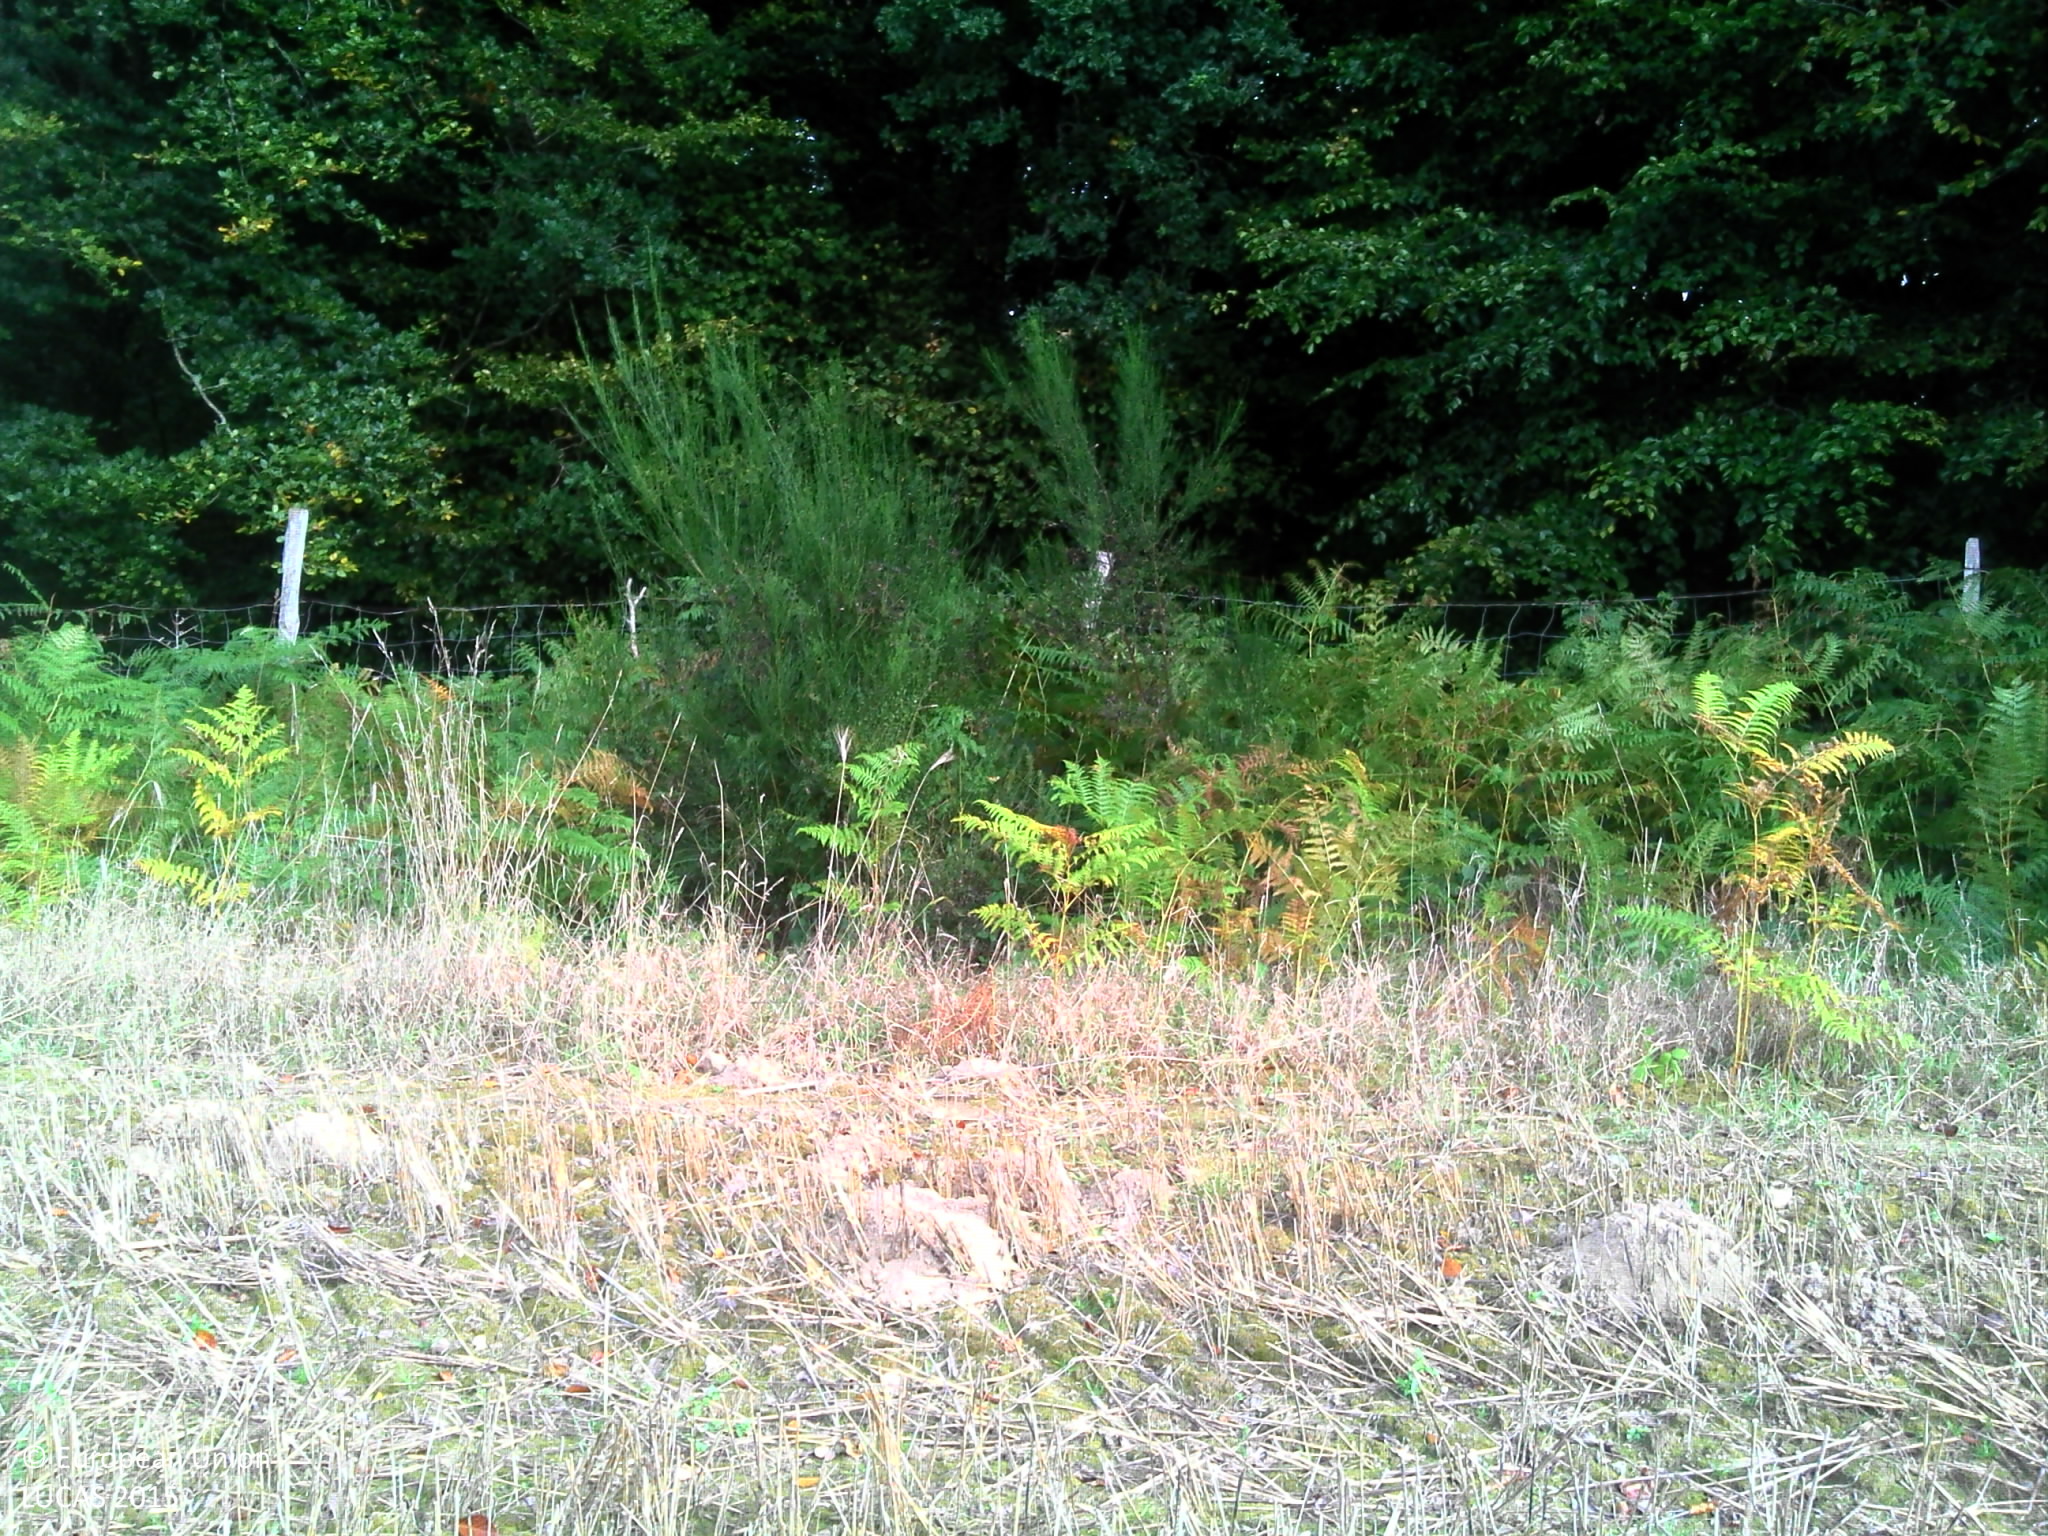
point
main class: Woodland
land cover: Broadleaved woodland
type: beech forest
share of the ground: > 75 %
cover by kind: broadleaved forest trees 100 %
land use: Forestry
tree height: > 5 m
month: October
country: FR
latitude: 48.5234
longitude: -3.1661
